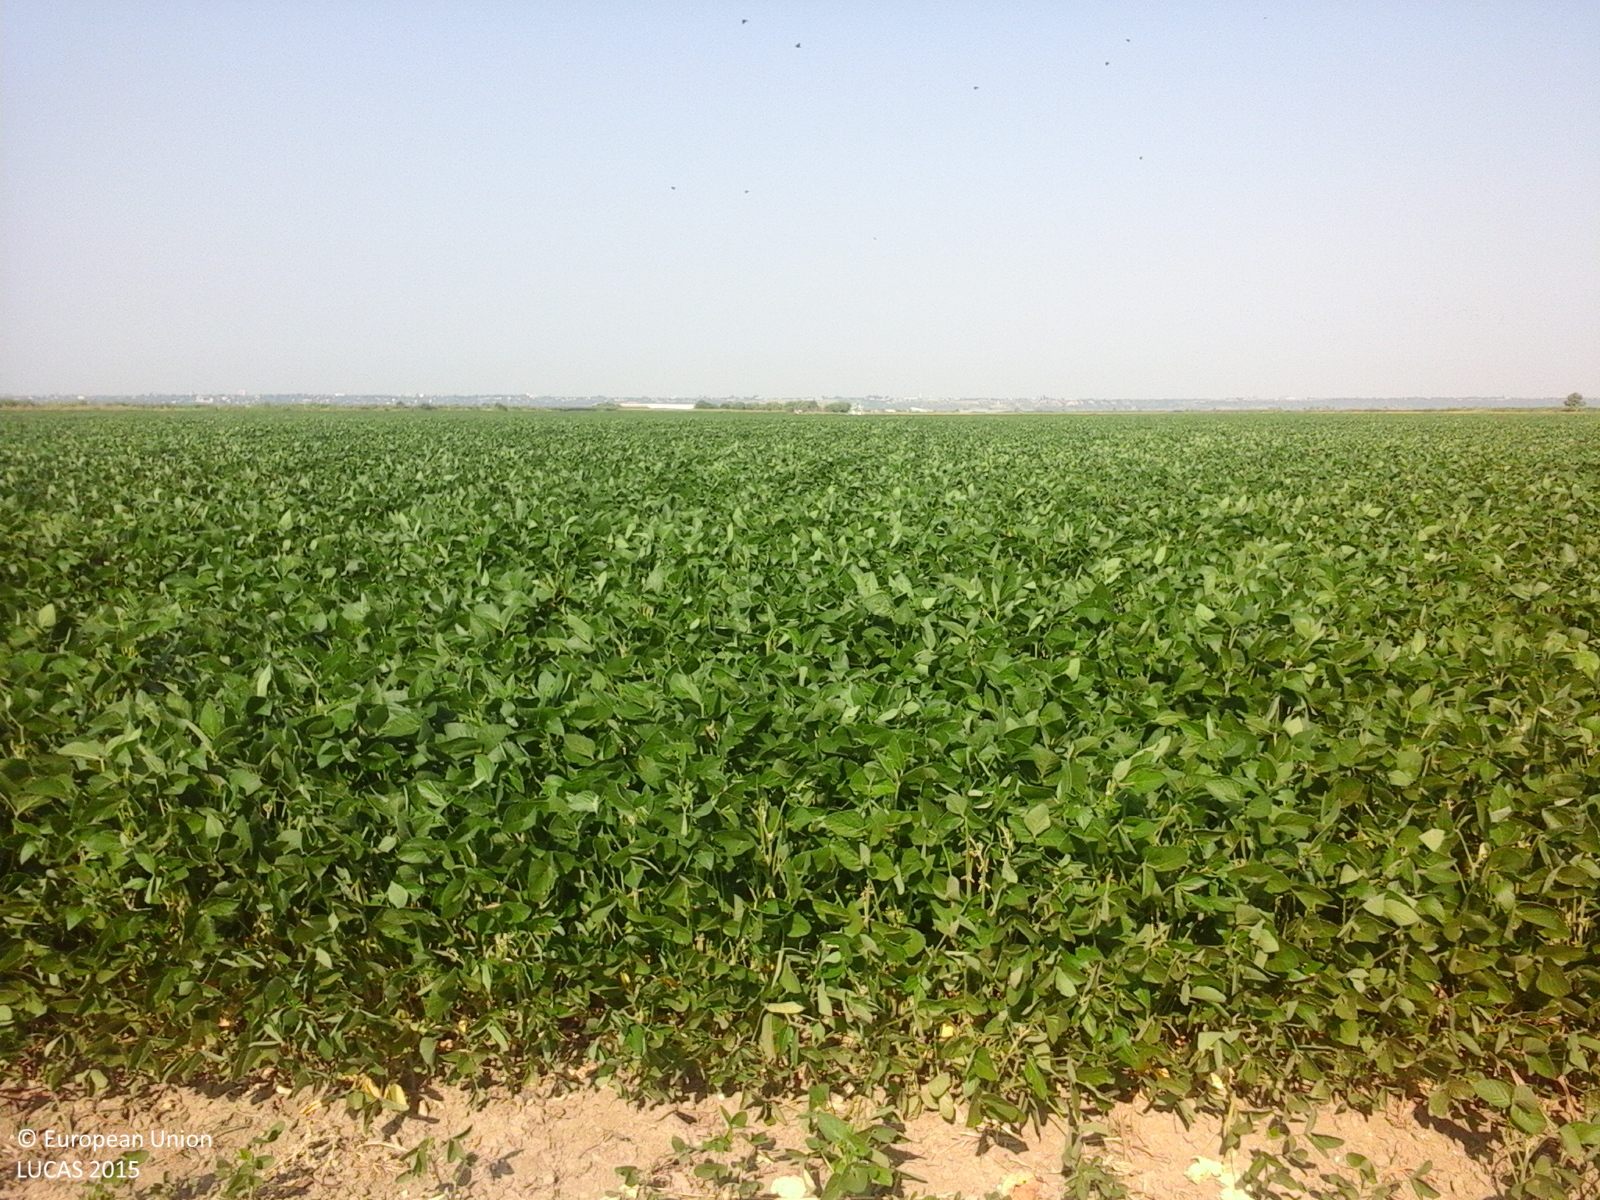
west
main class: Cropland
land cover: Soya
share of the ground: > 75 %
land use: Agriculture (excluding fallow land and kitchen gardens)
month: July
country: RO
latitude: 45.4826
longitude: 28.1486
